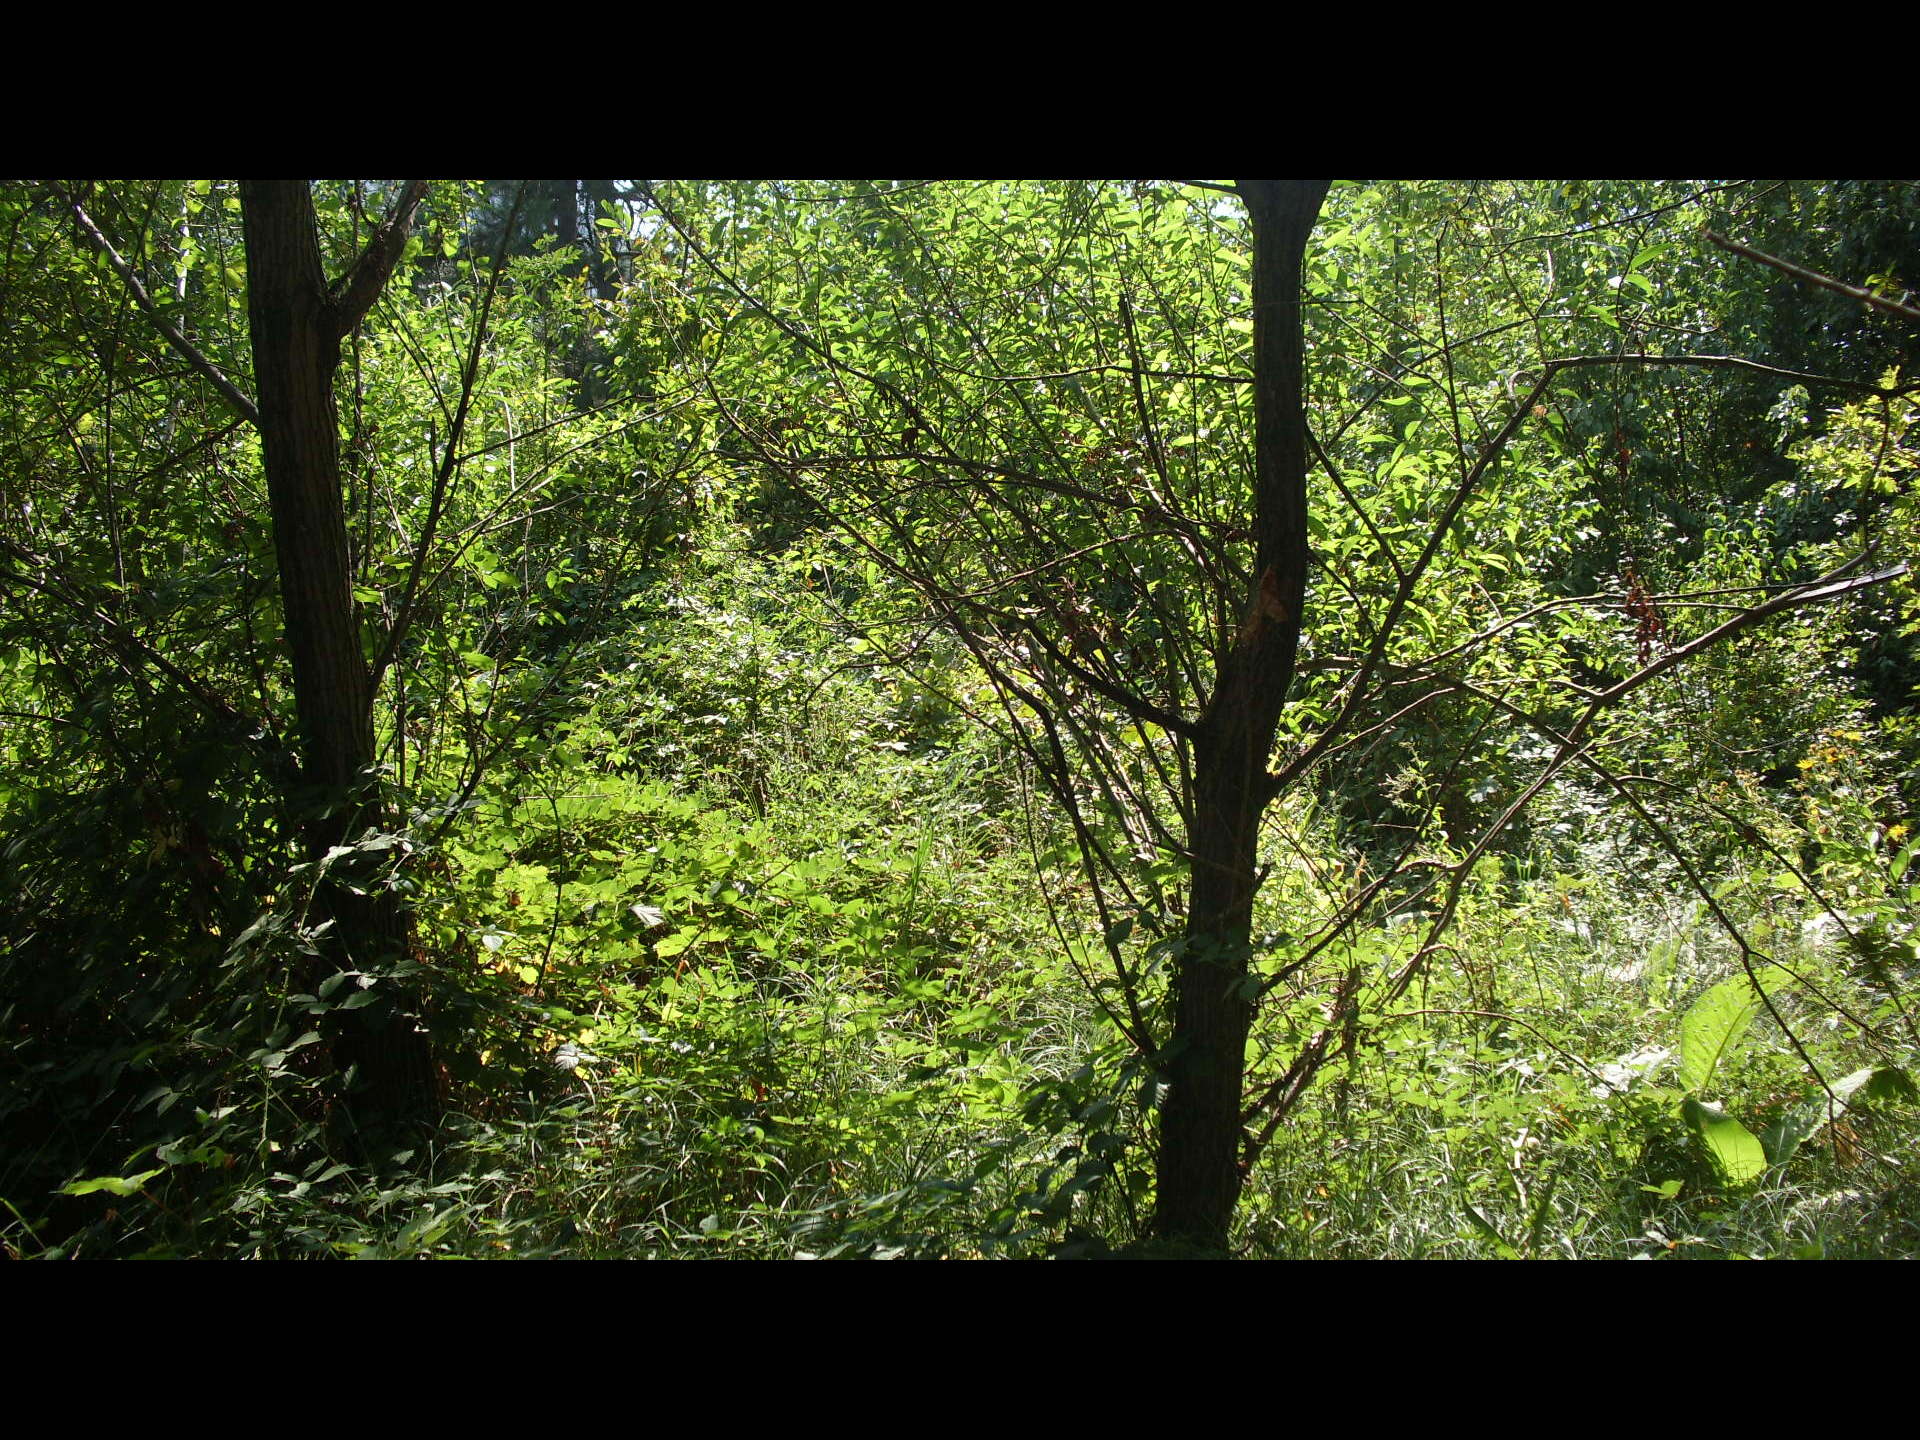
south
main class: Woodland
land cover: Broadleaved woodland
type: thermophilous deciduous forest
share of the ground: > 75 %
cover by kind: broadleaved forest trees 60 %, shrubs 30 %, herbaceous plants 10 %
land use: Forestry
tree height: > 5 m
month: August
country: BG
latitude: 43.2747
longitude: 23.4103
